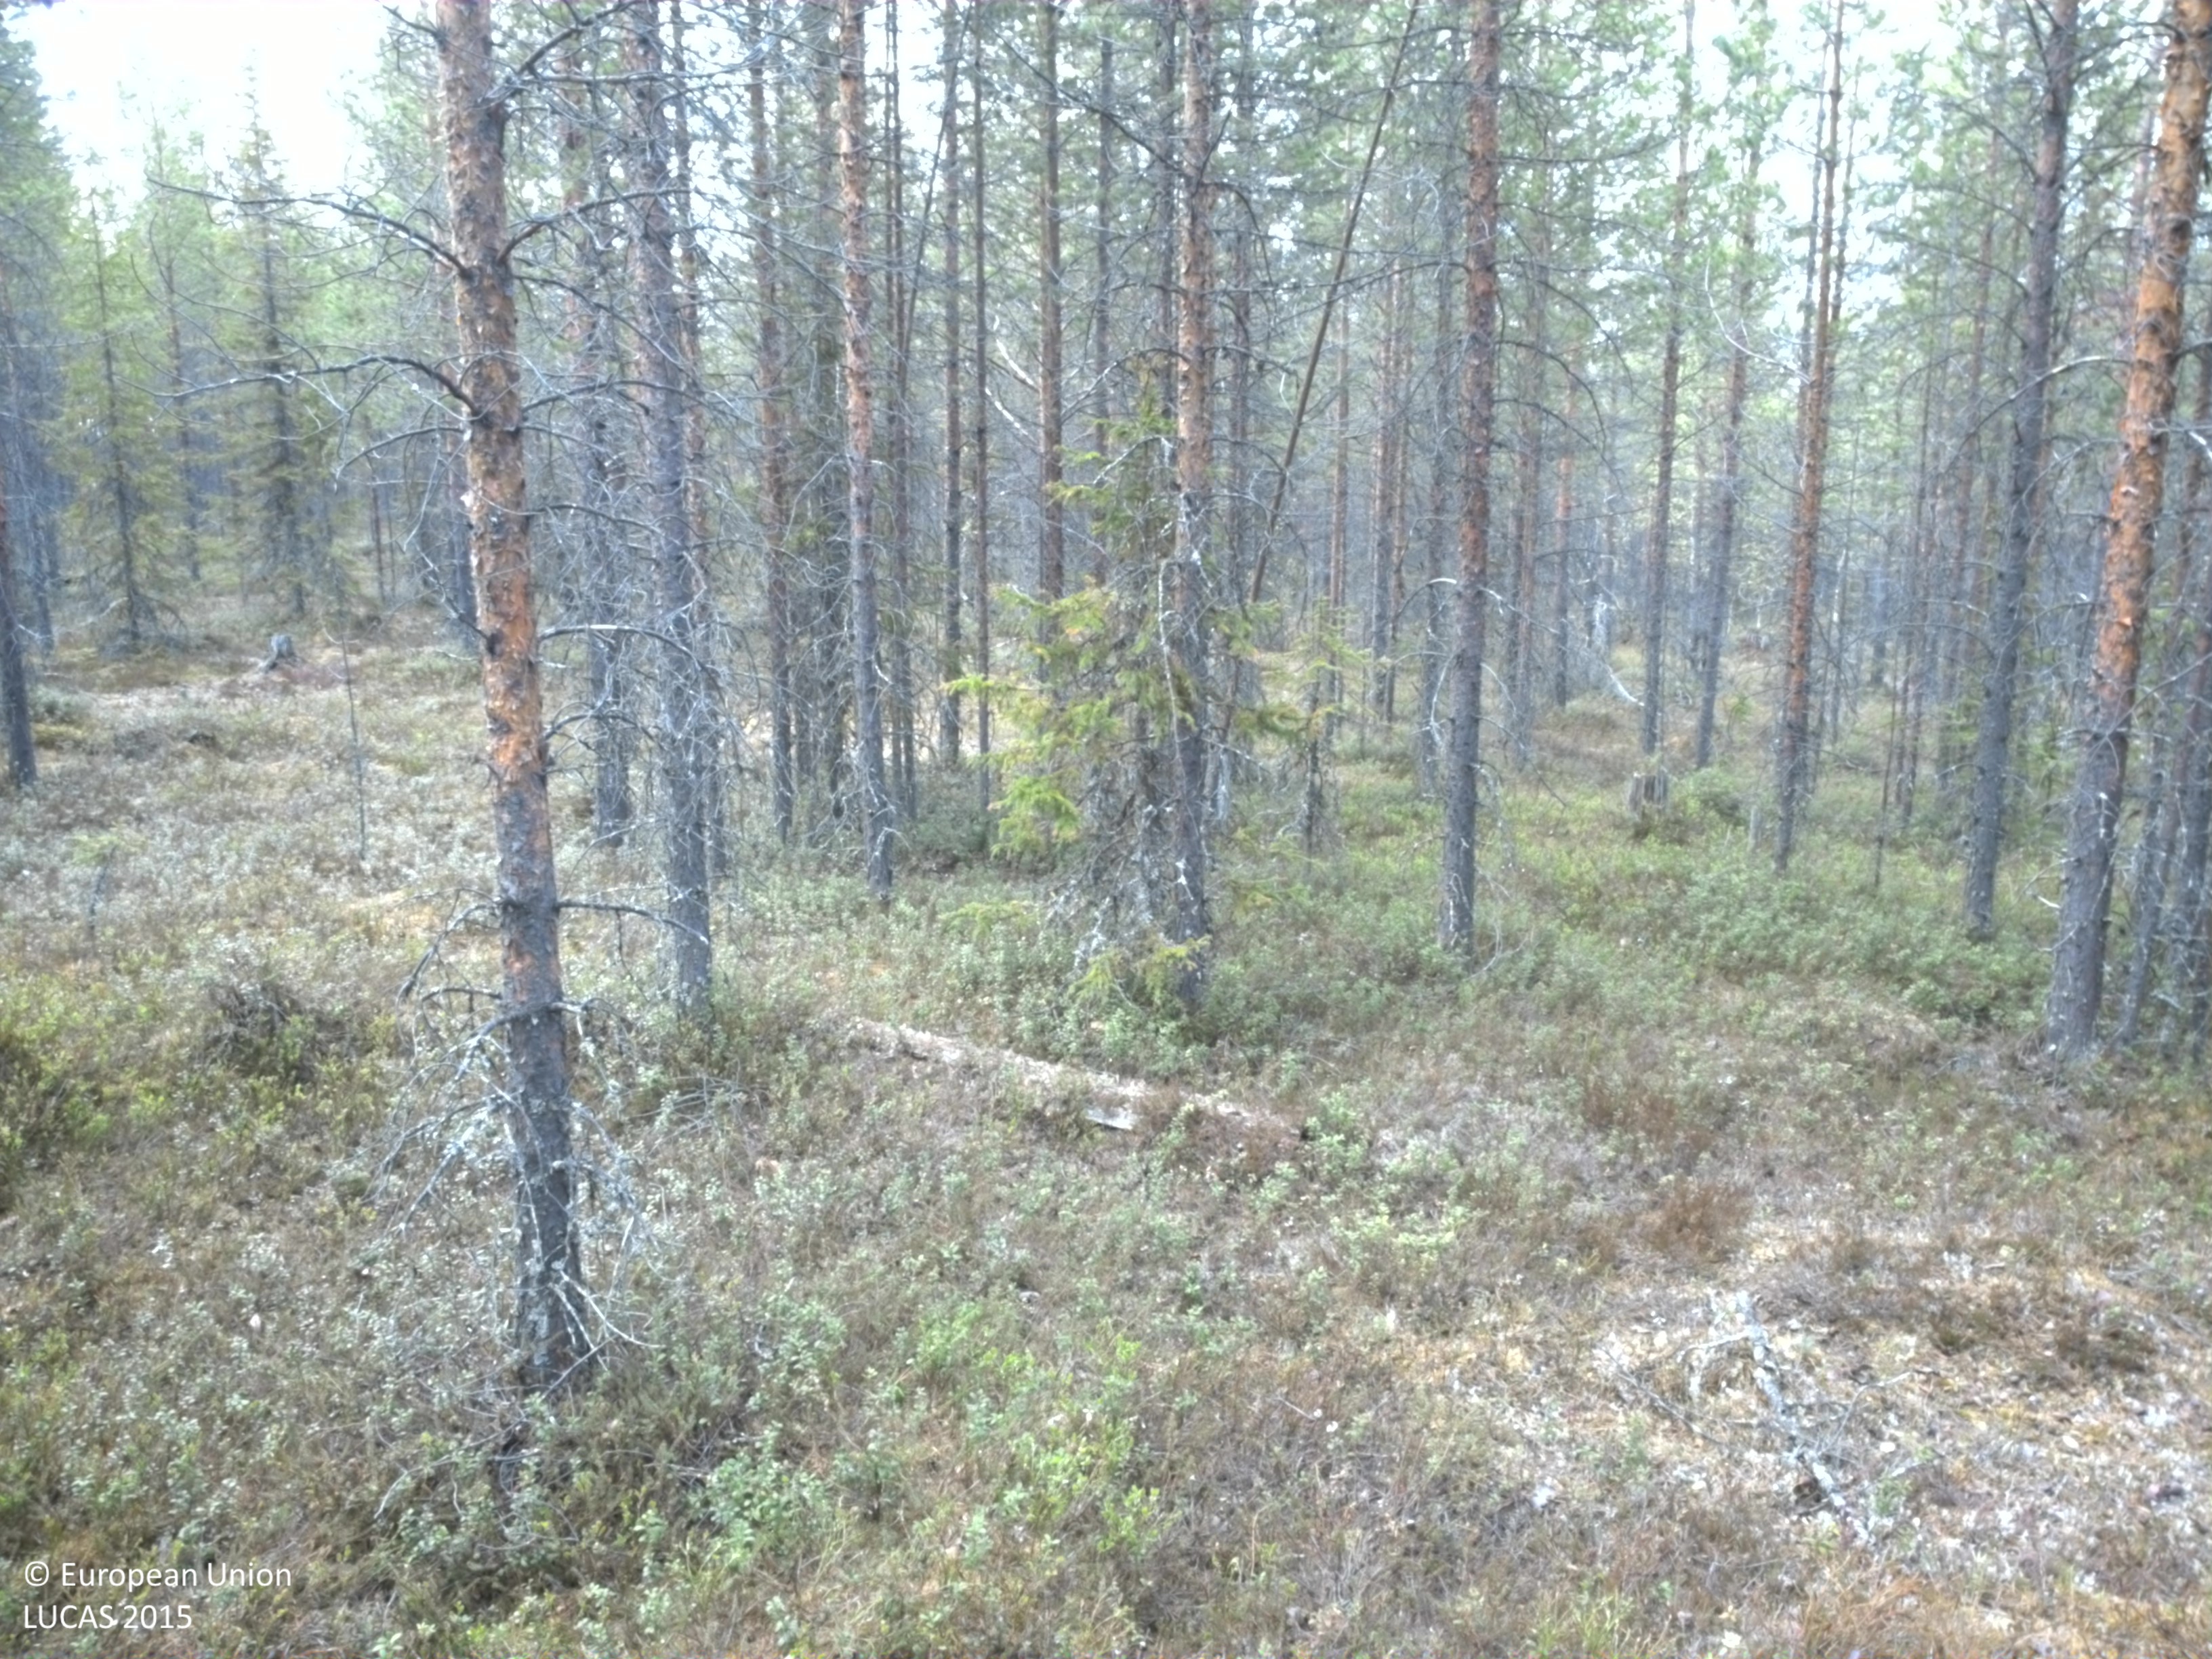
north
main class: Woodland
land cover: Pine dominated coniferous woodland
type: boreal forest
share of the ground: 50 - 75 %
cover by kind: coniferous forest trees 50 %, shrubs 45 %, consolidated bare surface 5 %
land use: Forestry
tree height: > 5 m
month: June
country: SE
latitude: 65.9752
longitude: 19.4448
